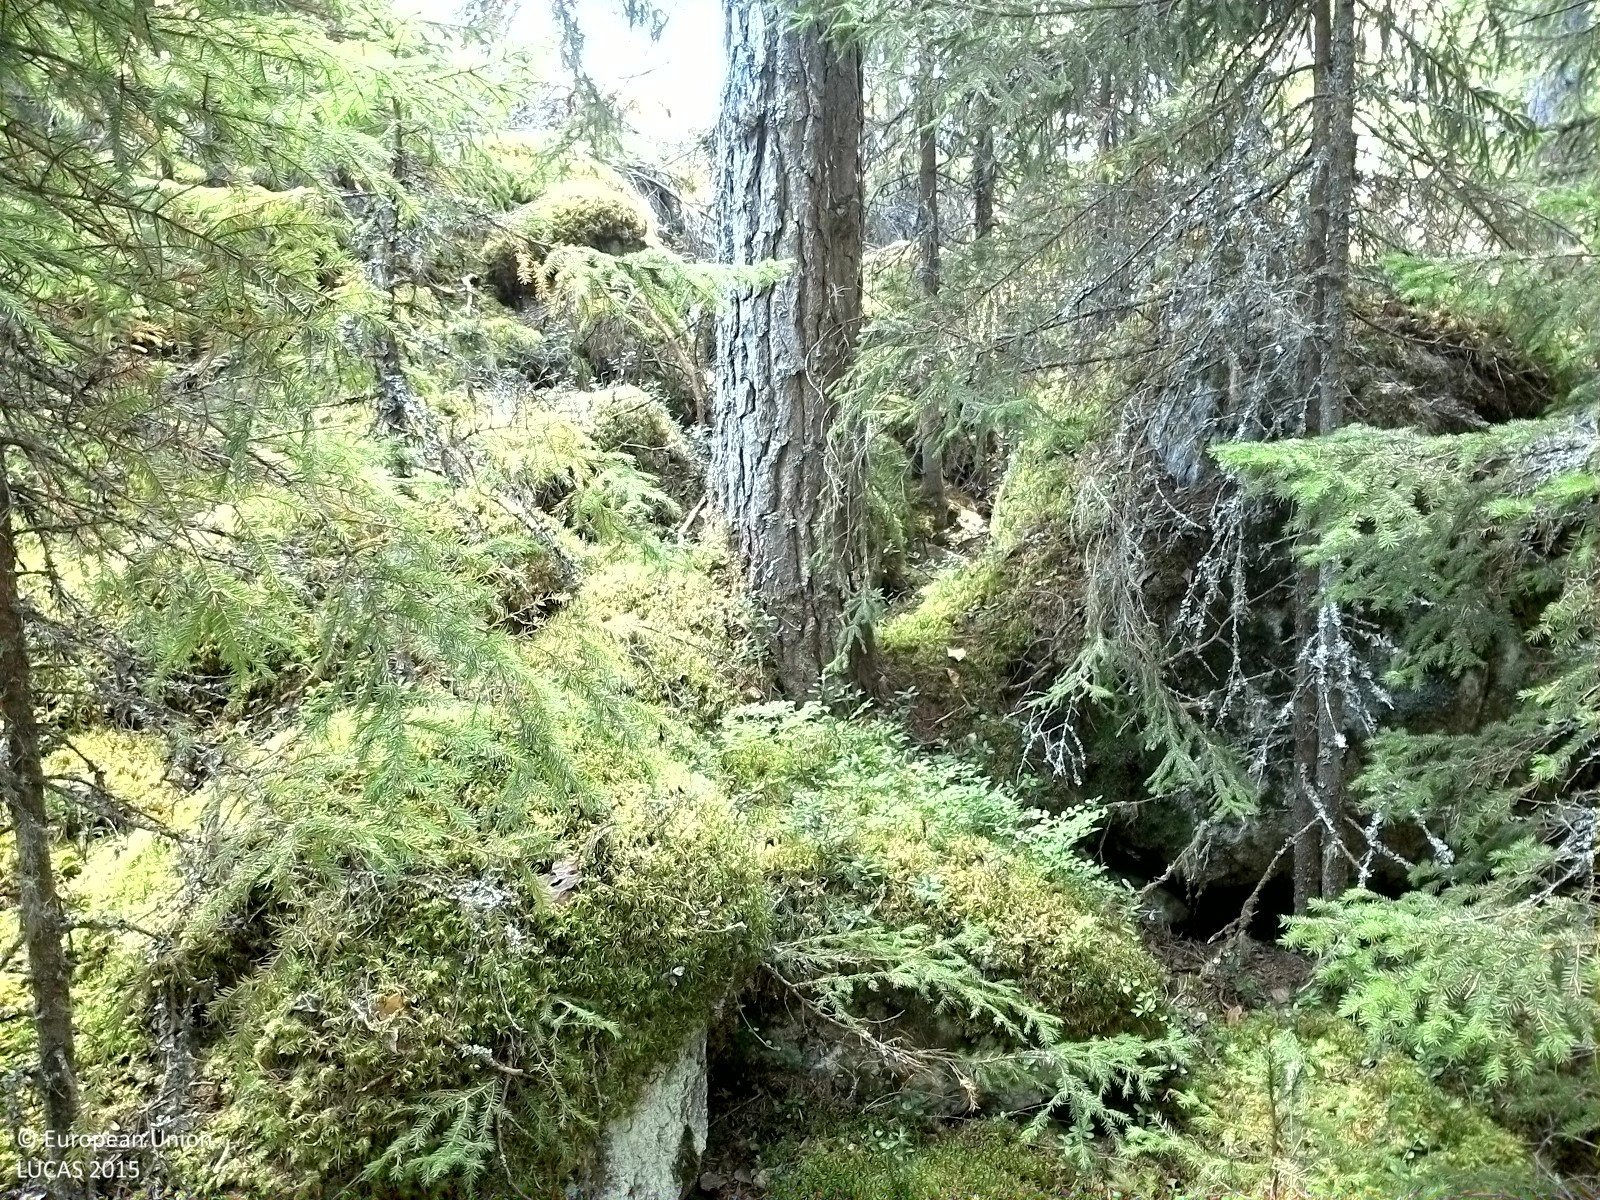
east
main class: Woodland
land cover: Spruce dominated coniferous woodland
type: boreal forest
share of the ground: > 75 %
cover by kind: coniferous forest trees 80 %, lichens and mosses 20 %
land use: Forestry
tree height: > 5 m
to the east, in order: Spruce dominated coniferous woodland; Other mixed woodland; Pine dominated mixed woodland; Pine dominated coniferous woodland
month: September
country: SE
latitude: 62.4567
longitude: 16.4344
